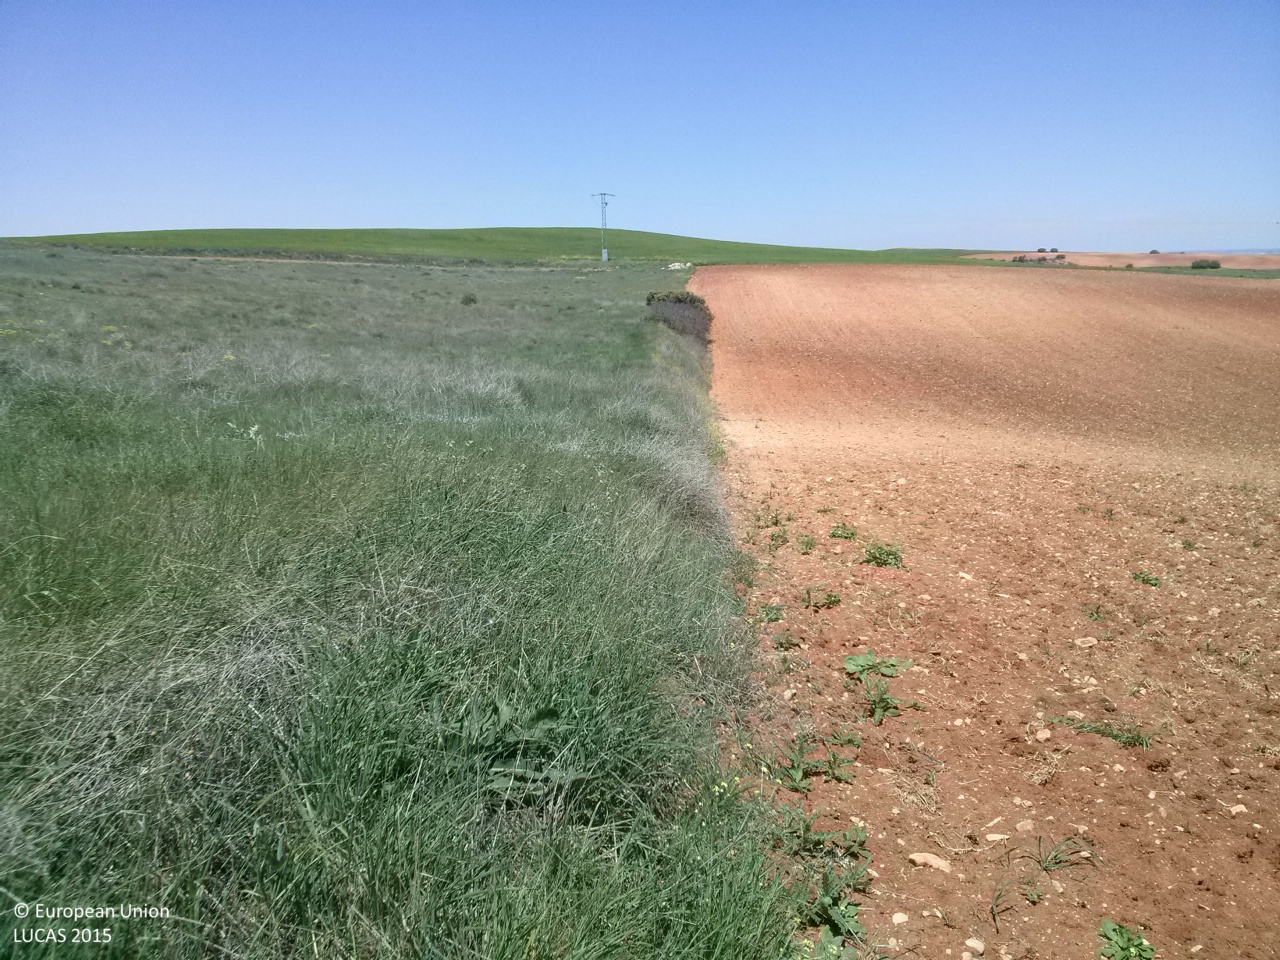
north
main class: Grassland
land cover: Spontaneously vegetated surfaces
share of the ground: 10 - 25 %
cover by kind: unconsolidated bare surface 85 %, herbaceous plants 15 %
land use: Fallow land
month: May
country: ES
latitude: 39.7846
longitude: -2.7103
